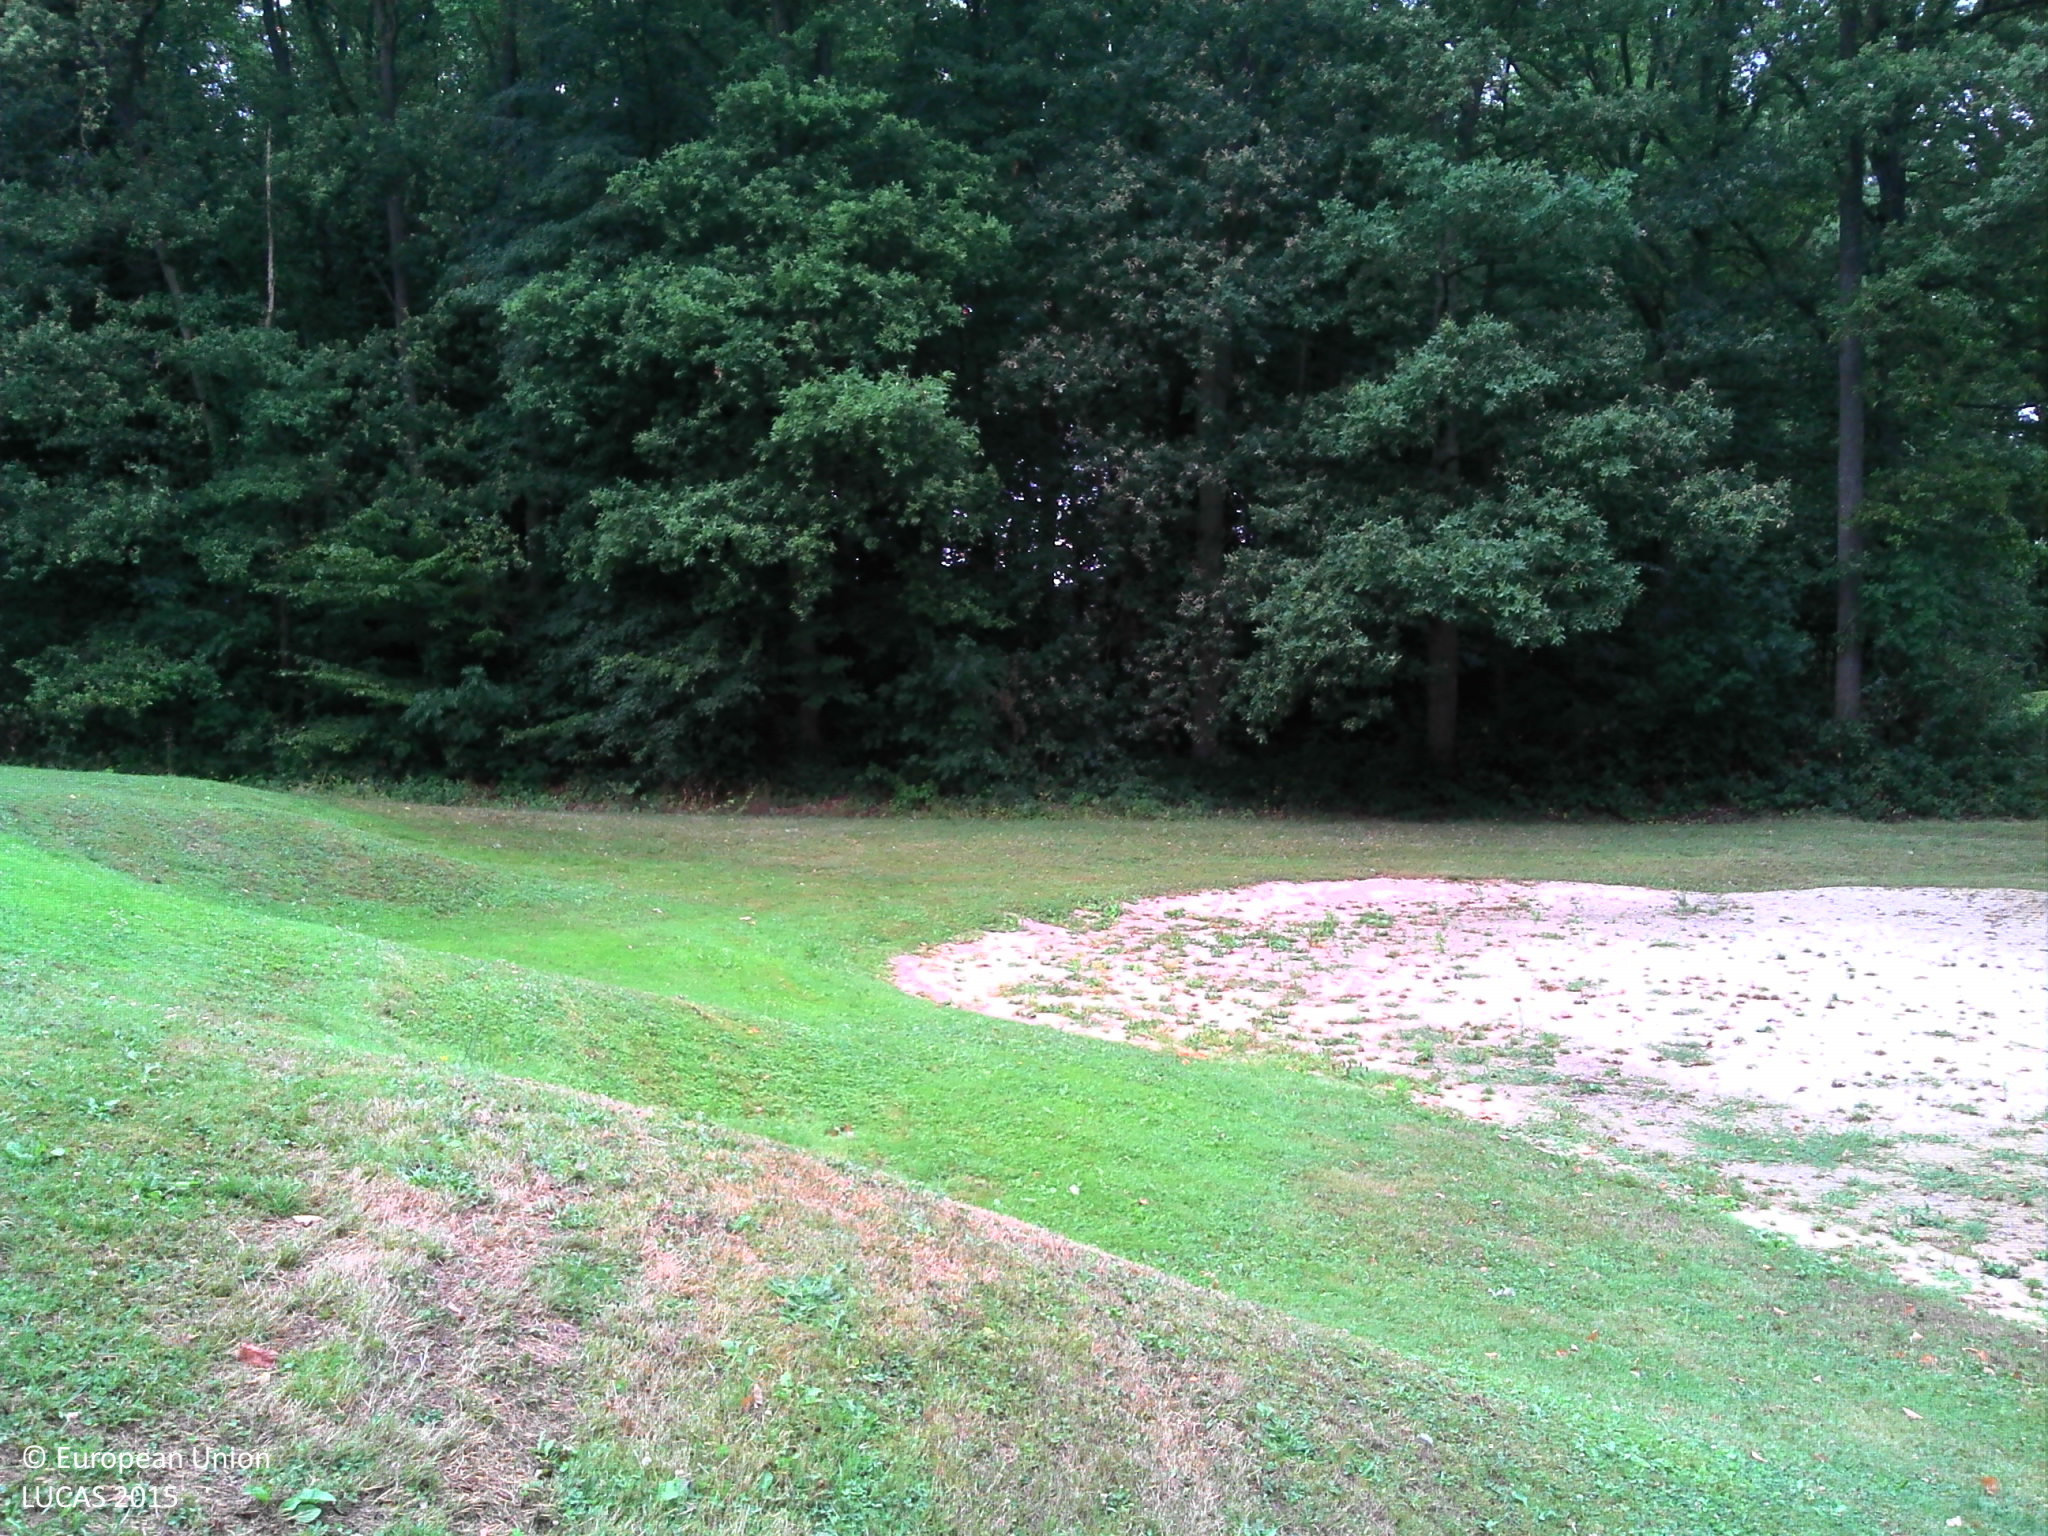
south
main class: Grassland
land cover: Grassland without tree/shrub cover
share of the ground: > 75 %
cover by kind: herbaceous plants 70 %, lichens and mosses 5 %
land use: Sport
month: July
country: FR
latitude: 48.7411
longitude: 2.7149
